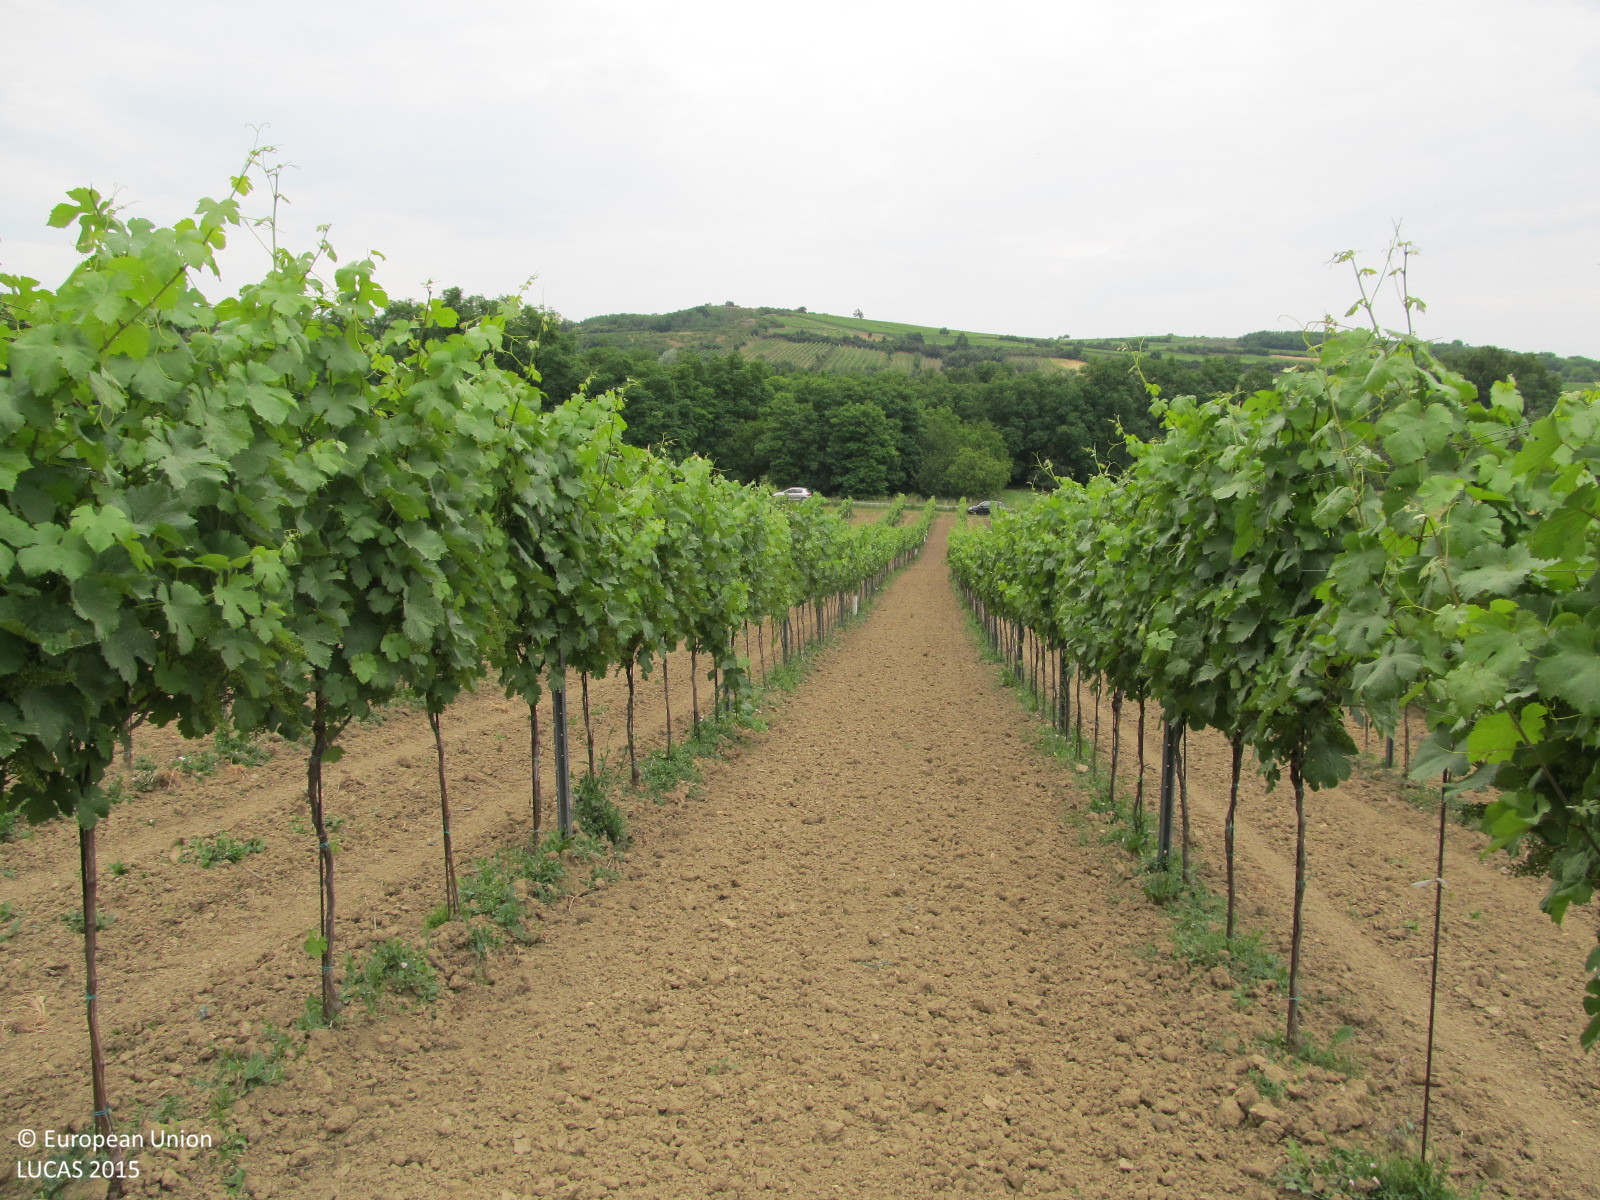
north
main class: Cropland
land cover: Vineyards
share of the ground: 25 - 50 %
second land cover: Other bare soil
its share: > 75 %
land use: Agriculture (excluding fallow land and kitchen gardens)
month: June
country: AT
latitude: 48.6947
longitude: 15.9413
